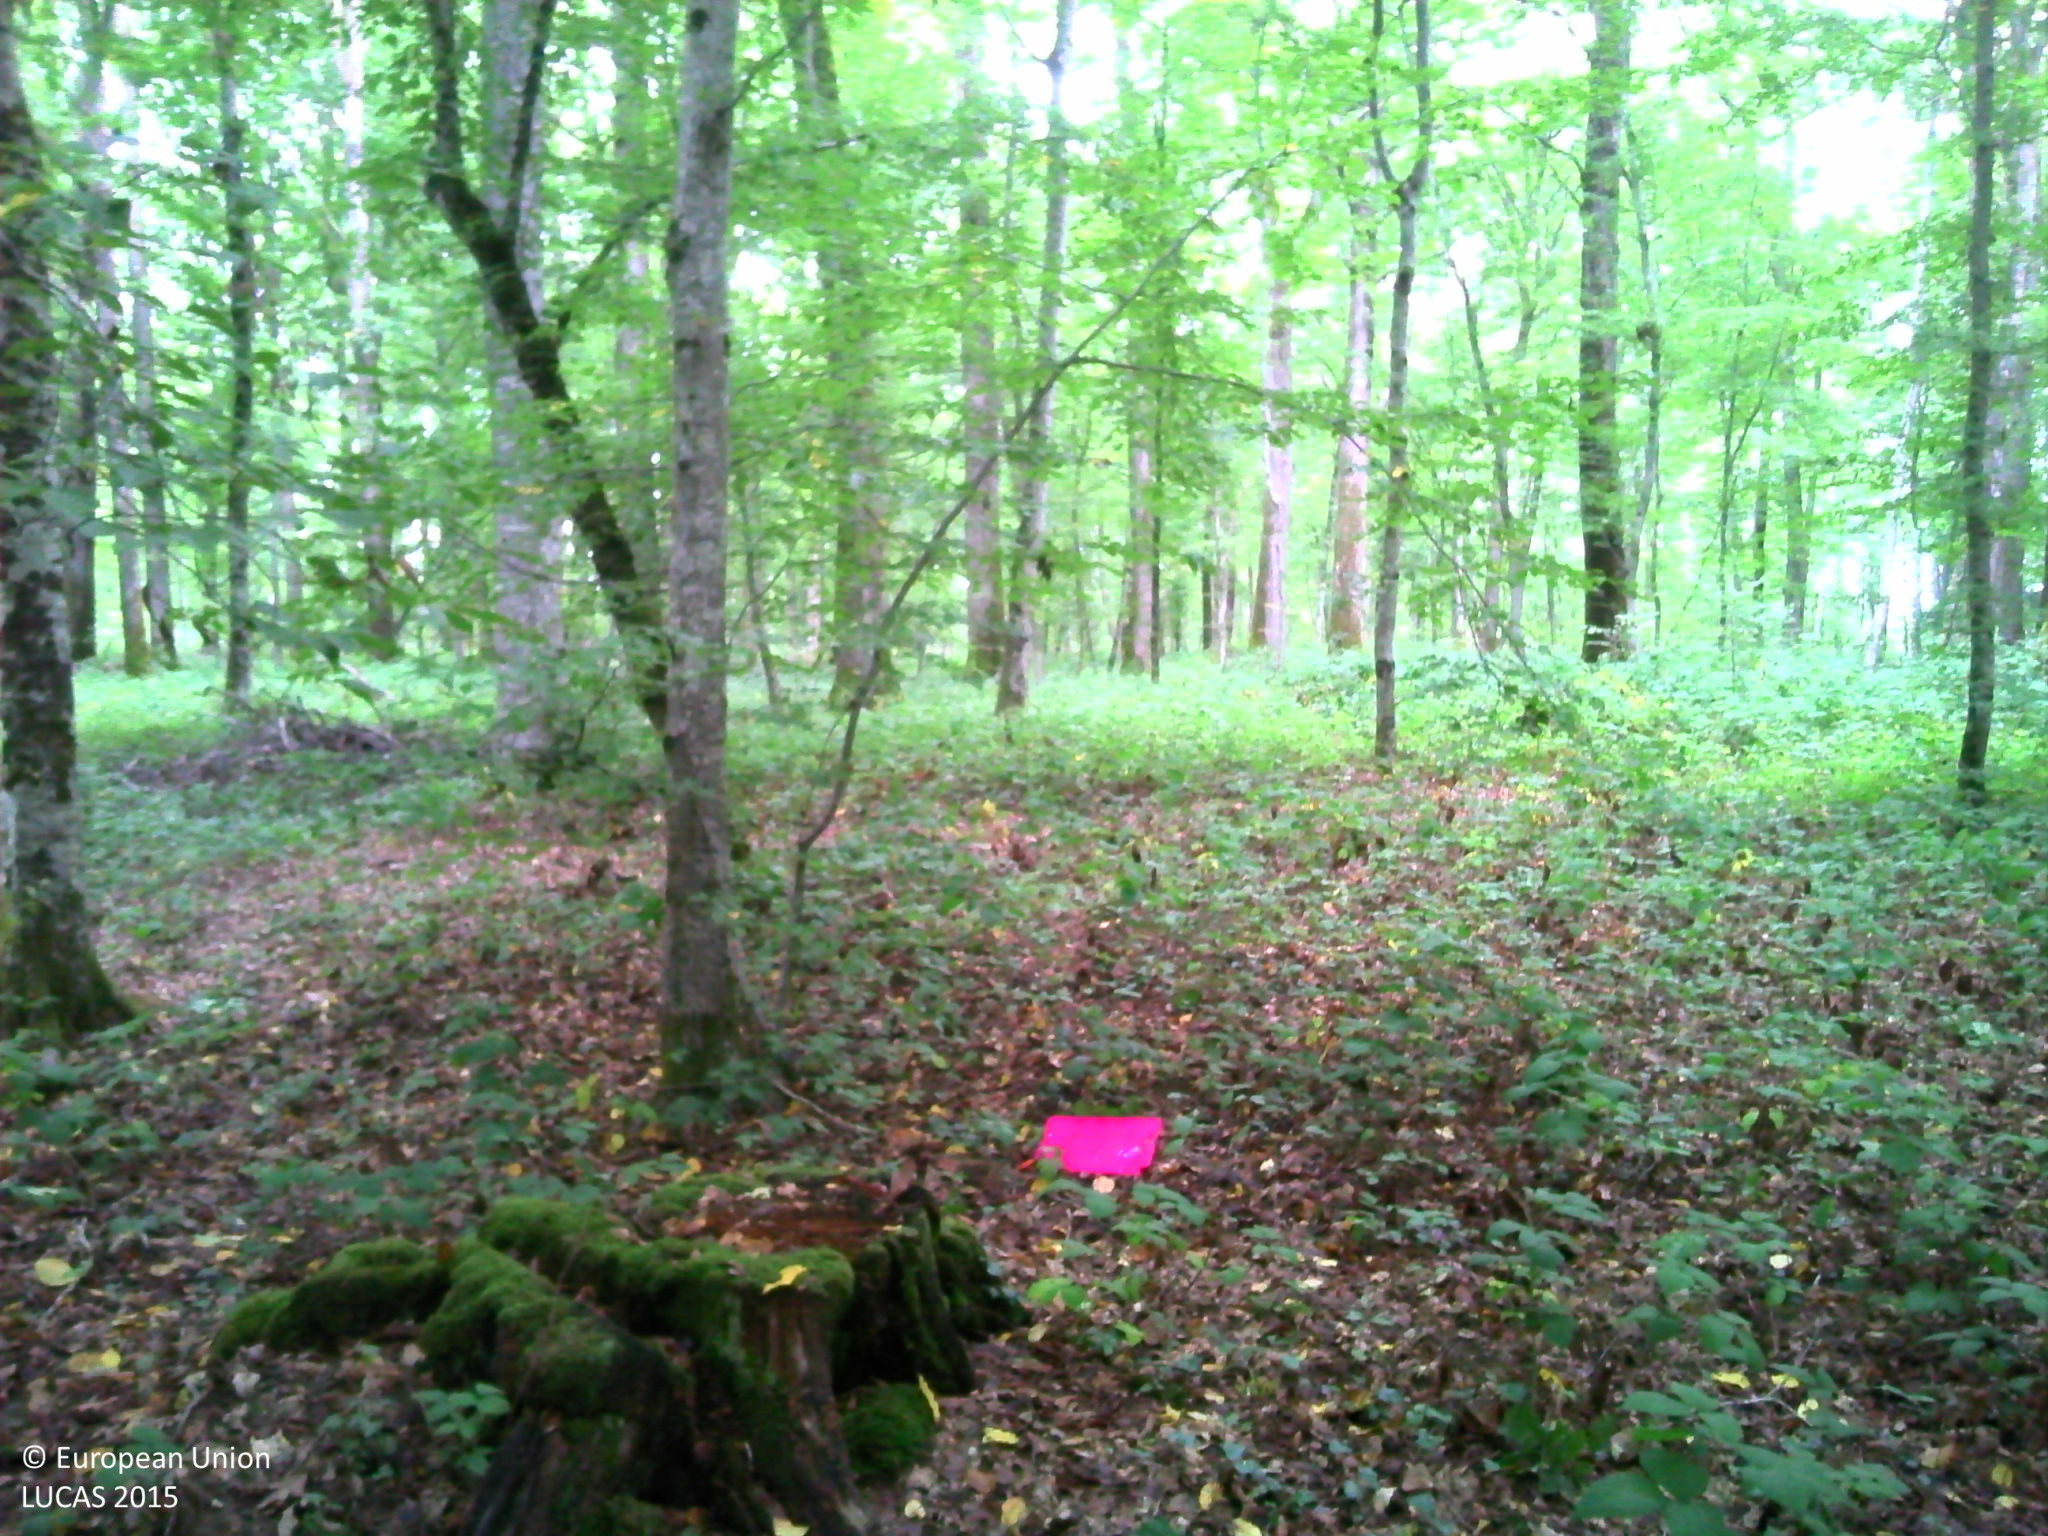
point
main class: Woodland
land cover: Broadleaved woodland
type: mesophytic deciduous forest
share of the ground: > 75 %
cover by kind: broadleaved forest trees 100 %
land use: Forestry
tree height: > 5 m
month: September
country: FR
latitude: 47.1621
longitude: 4.4198
